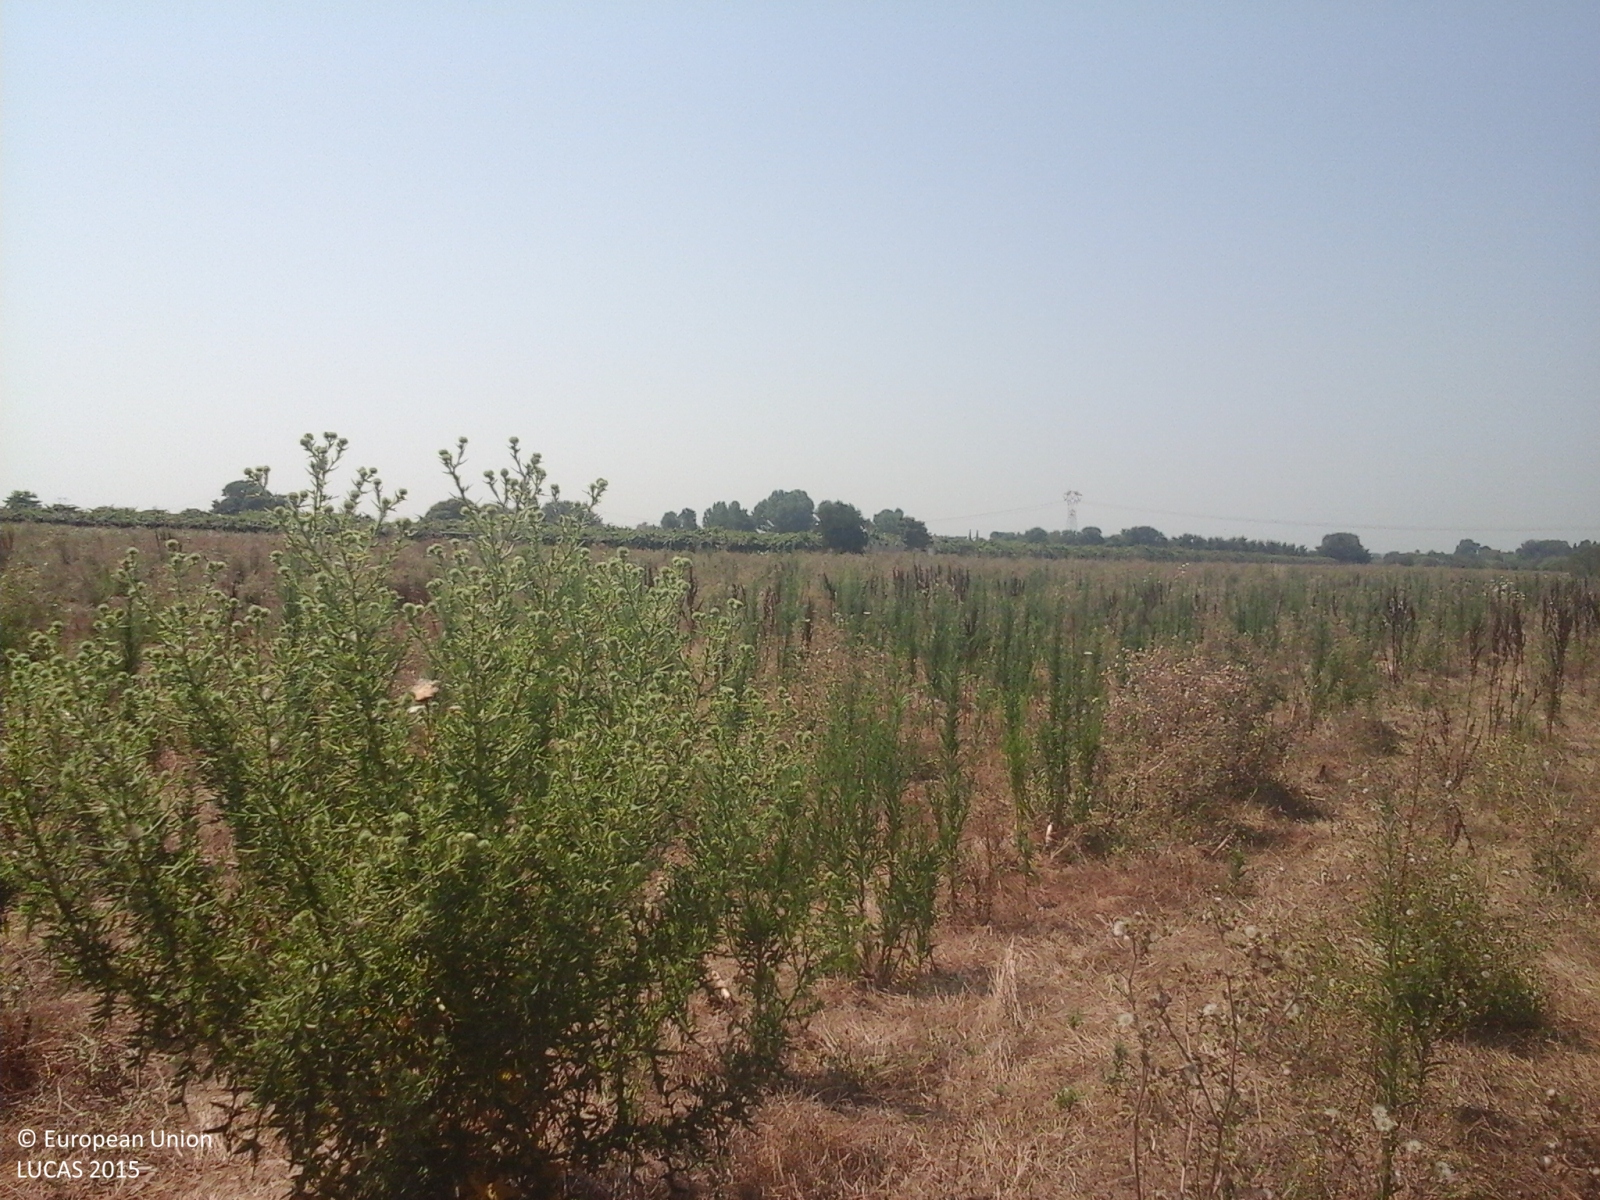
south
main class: Grassland
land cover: Grassland without tree/shrub cover
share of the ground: > 75 %
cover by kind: herbaceous plants 100 %
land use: Agriculture (excluding fallow land and kitchen gardens)
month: July
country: IT
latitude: 41.5866
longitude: 12.7362
